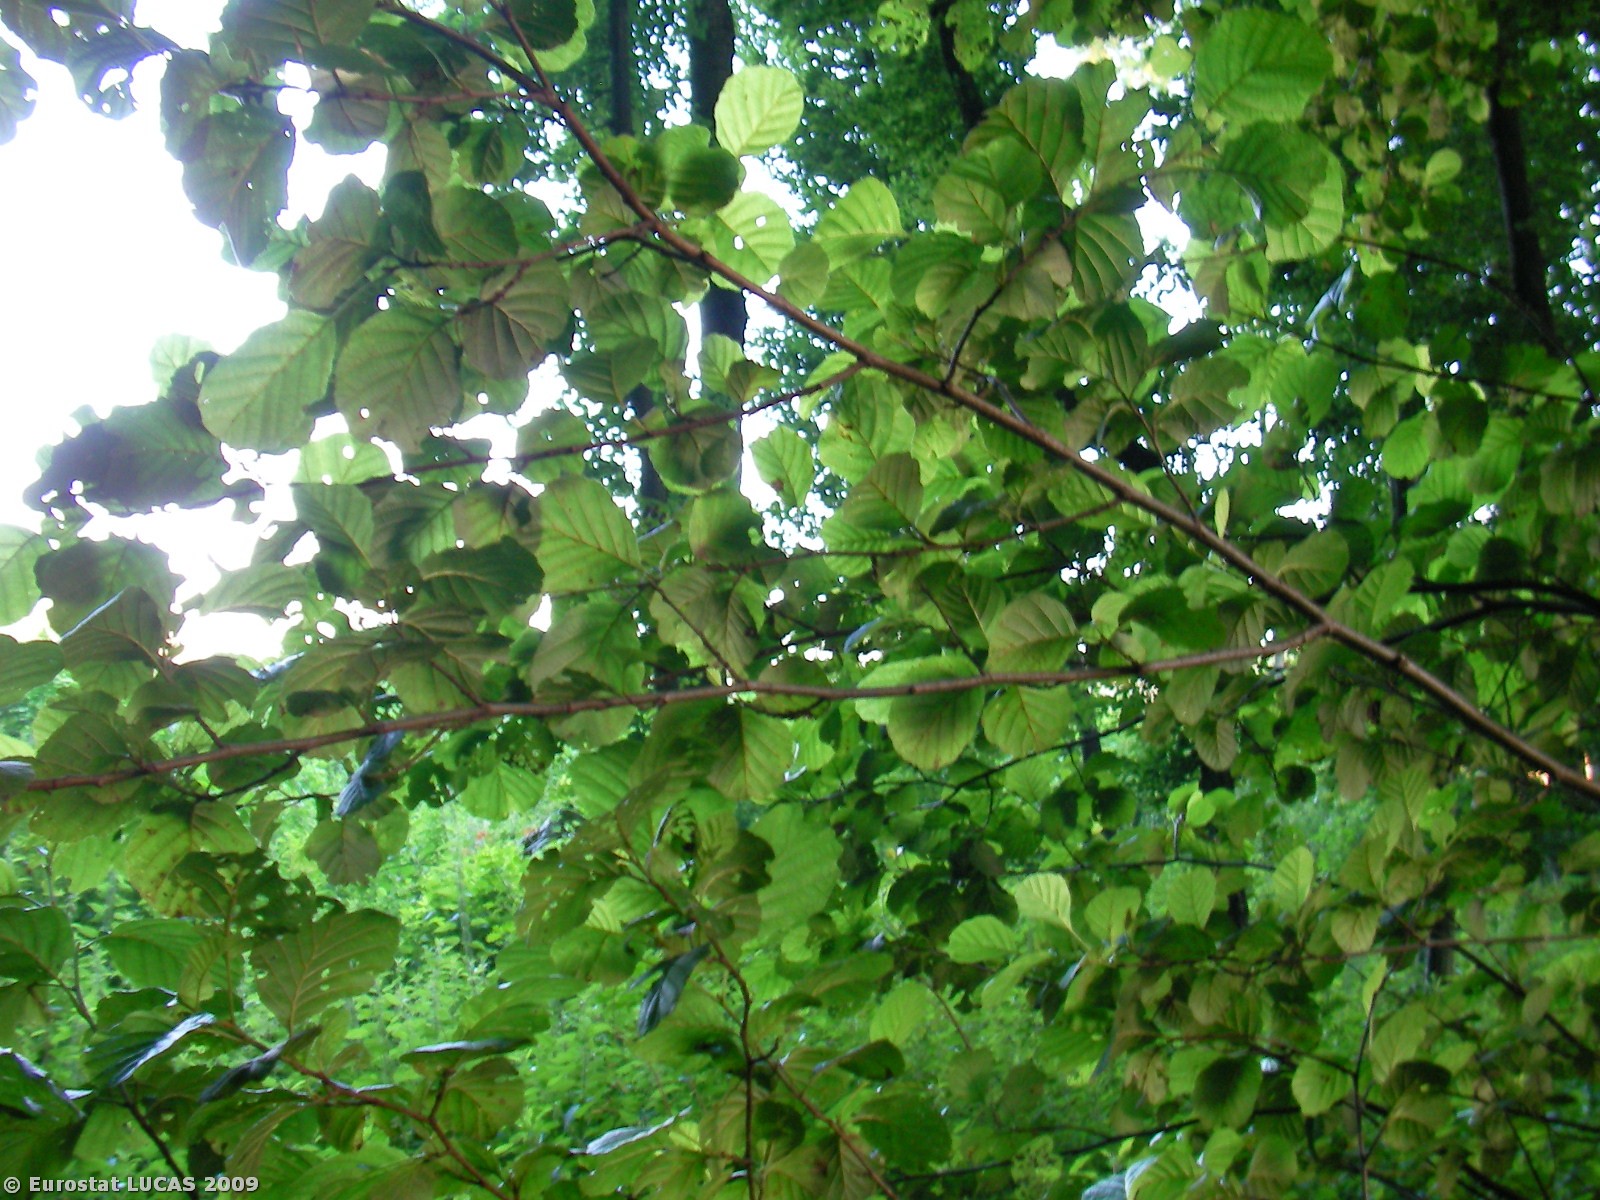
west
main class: Woodland
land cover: Broadleaved woodland
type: beech forest
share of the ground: > 75 %
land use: Forestry
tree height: > 5 m
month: July
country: AT
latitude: 46.9745
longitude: 15.7183
